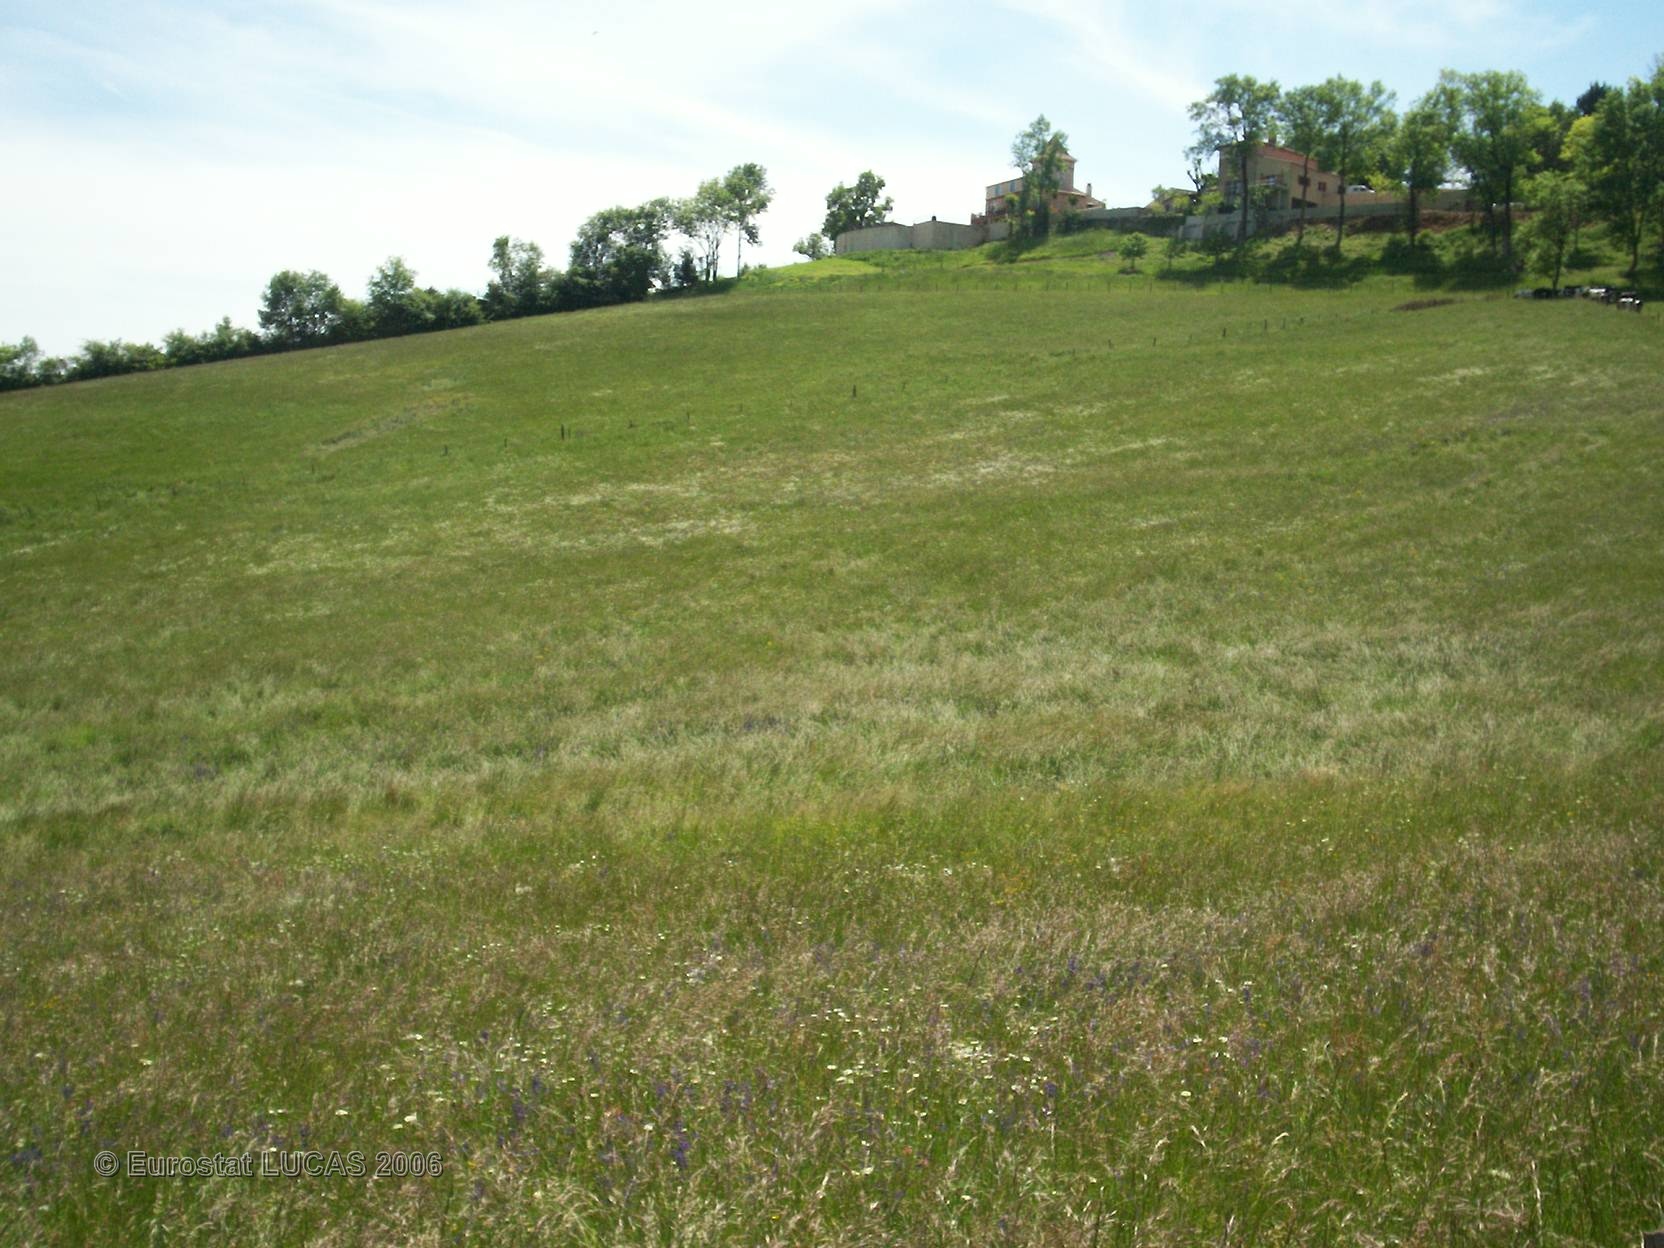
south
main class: Grassland
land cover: Grassland without tree/shrub cover
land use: Agriculture (excluding fallow land and kitchen gardens)
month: May
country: FR
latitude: 44.0934
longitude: 1.9710
